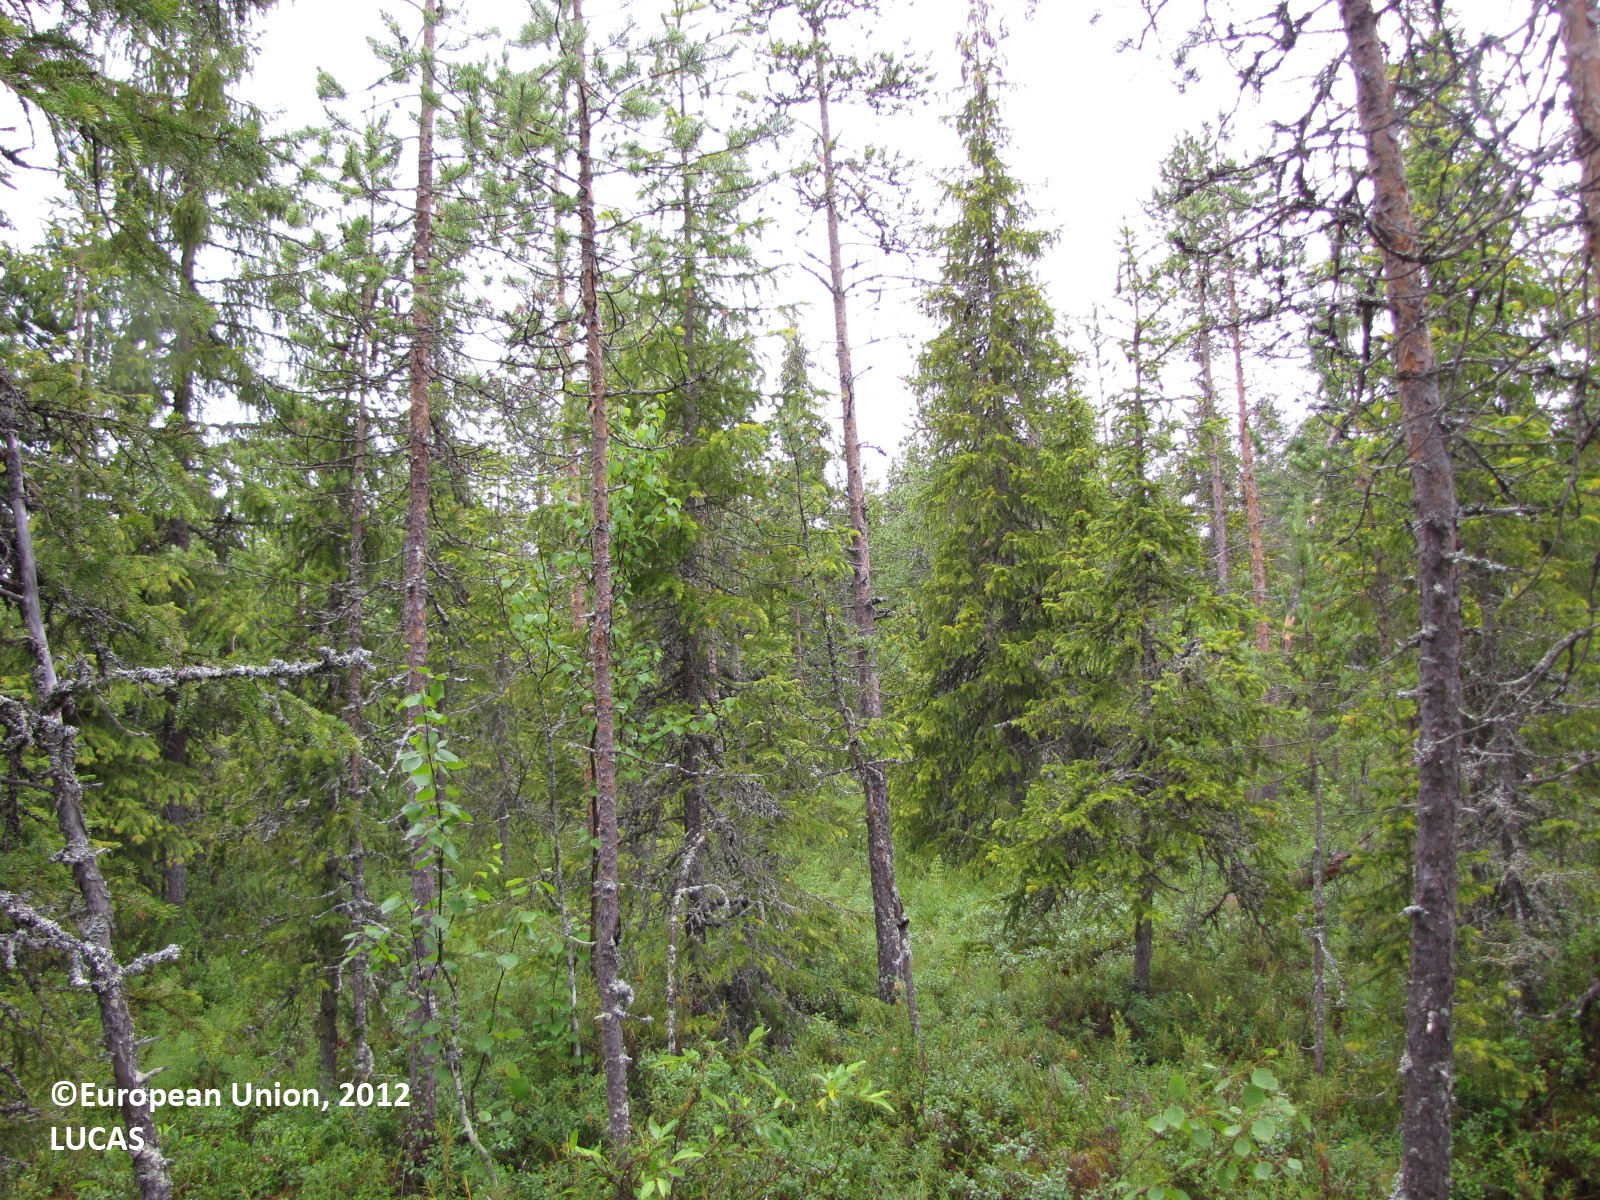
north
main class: Woodland
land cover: Other mixed woodland
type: boreal forest
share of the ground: 50 - 75 %
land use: Forestry
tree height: > 5 m
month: July
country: FI
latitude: 66.6220
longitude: 24.7499
